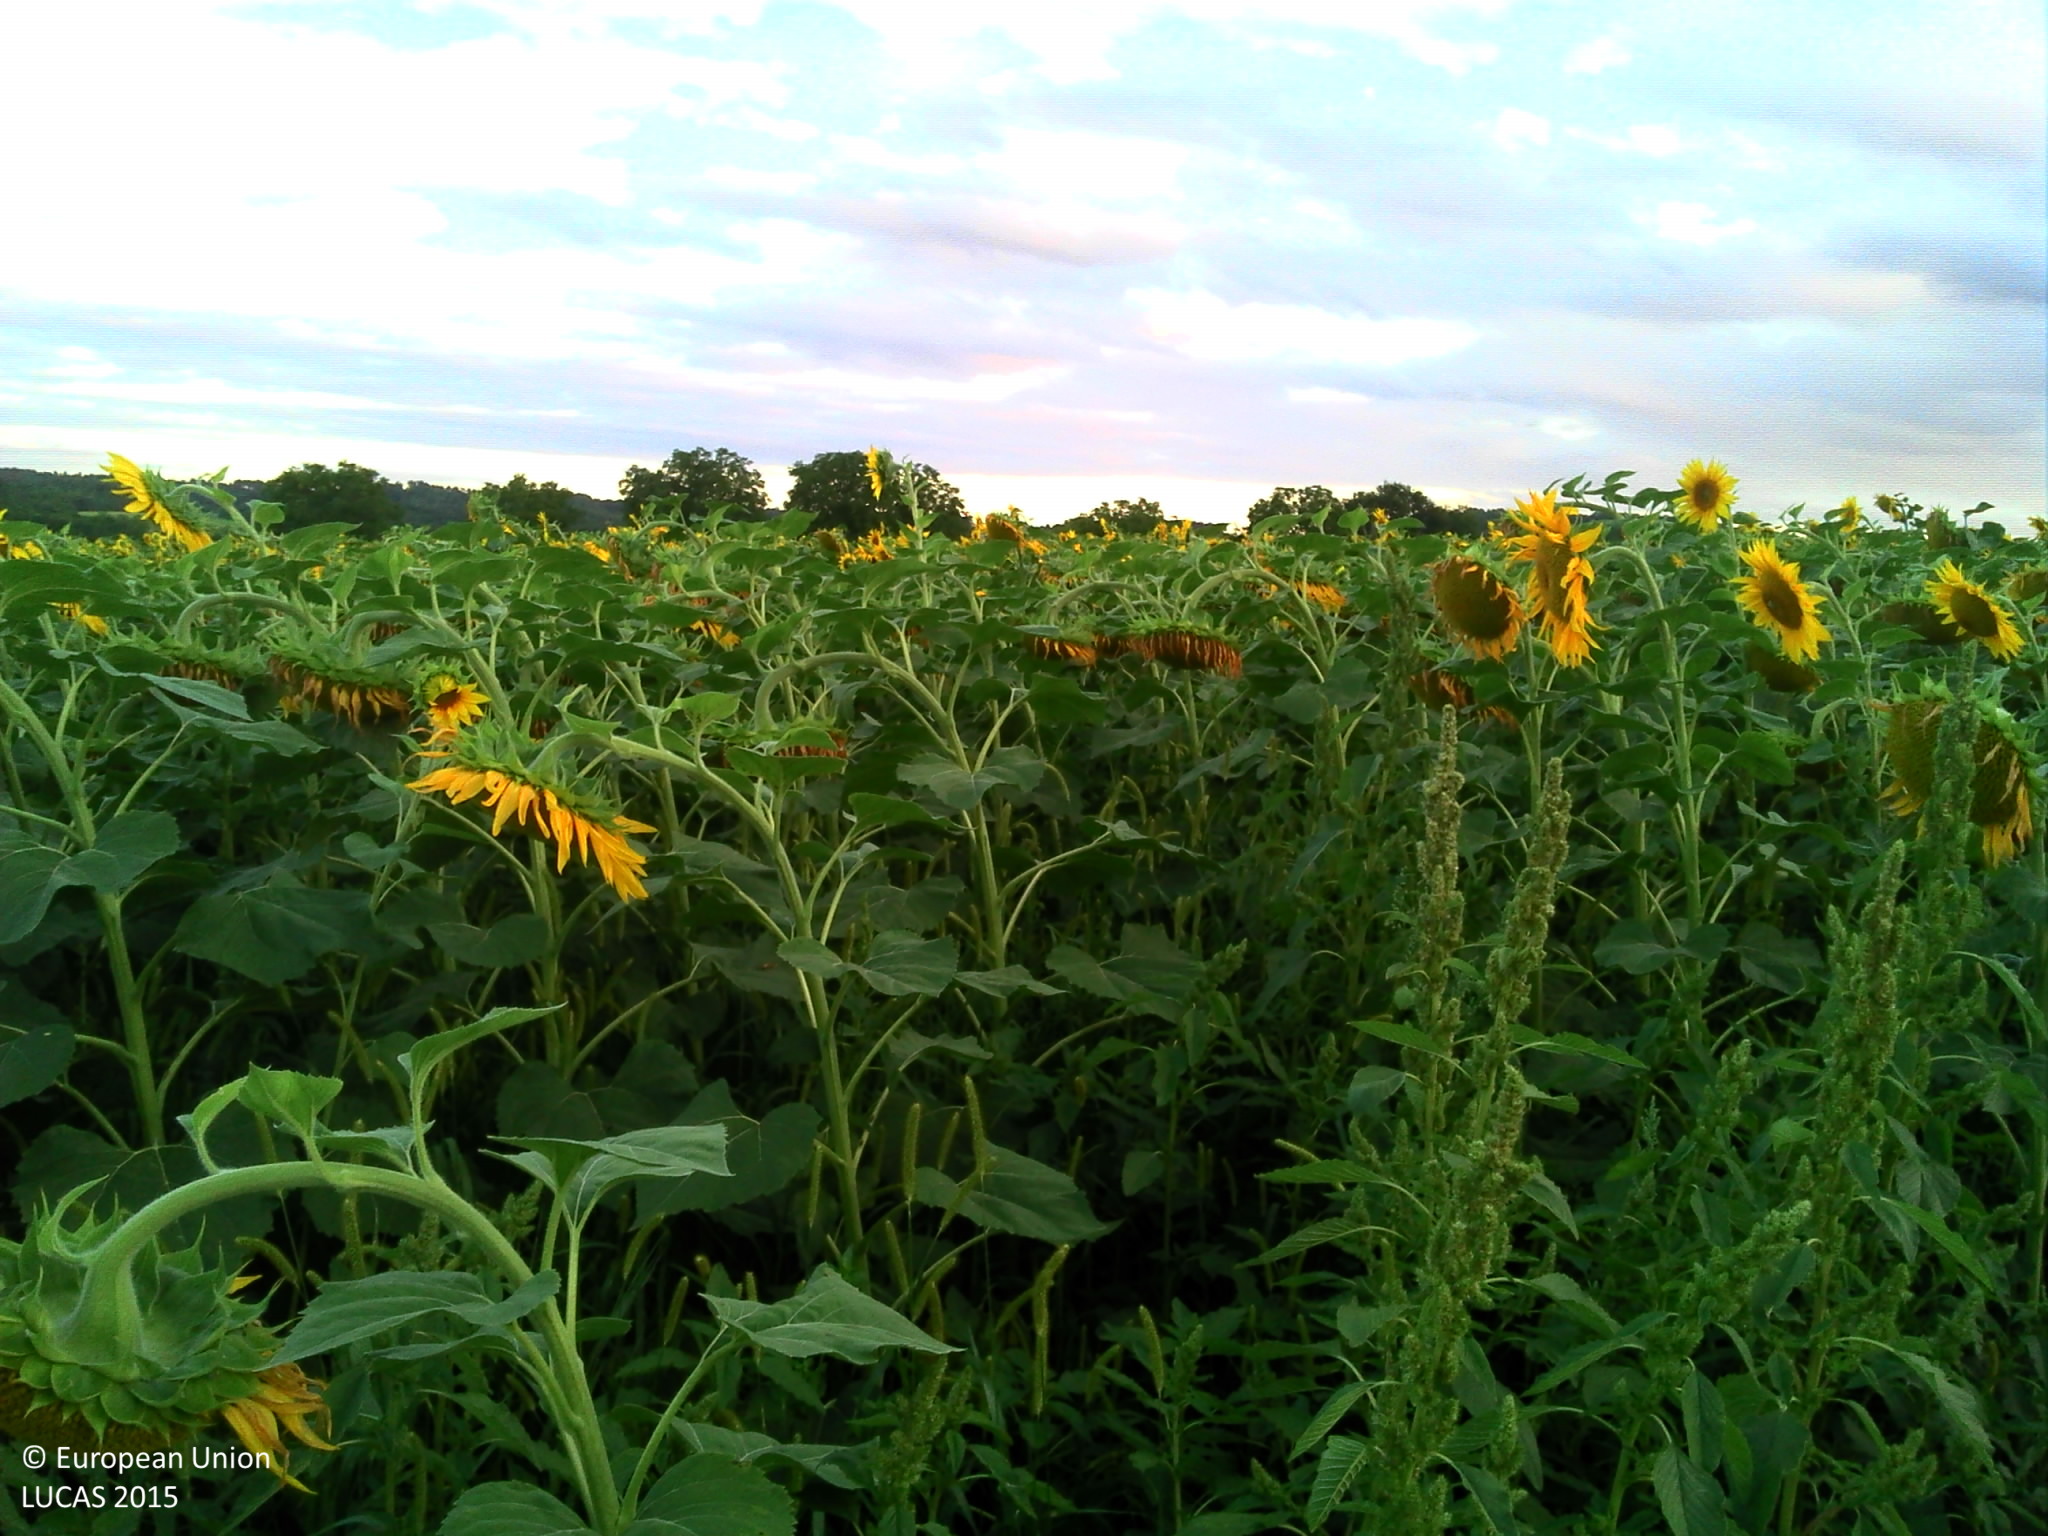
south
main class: Cropland
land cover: Sunflower
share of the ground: > 75 %
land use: Agriculture (excluding fallow land and kitchen gardens)
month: August
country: FR
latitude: 45.2336
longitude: 0.4474
